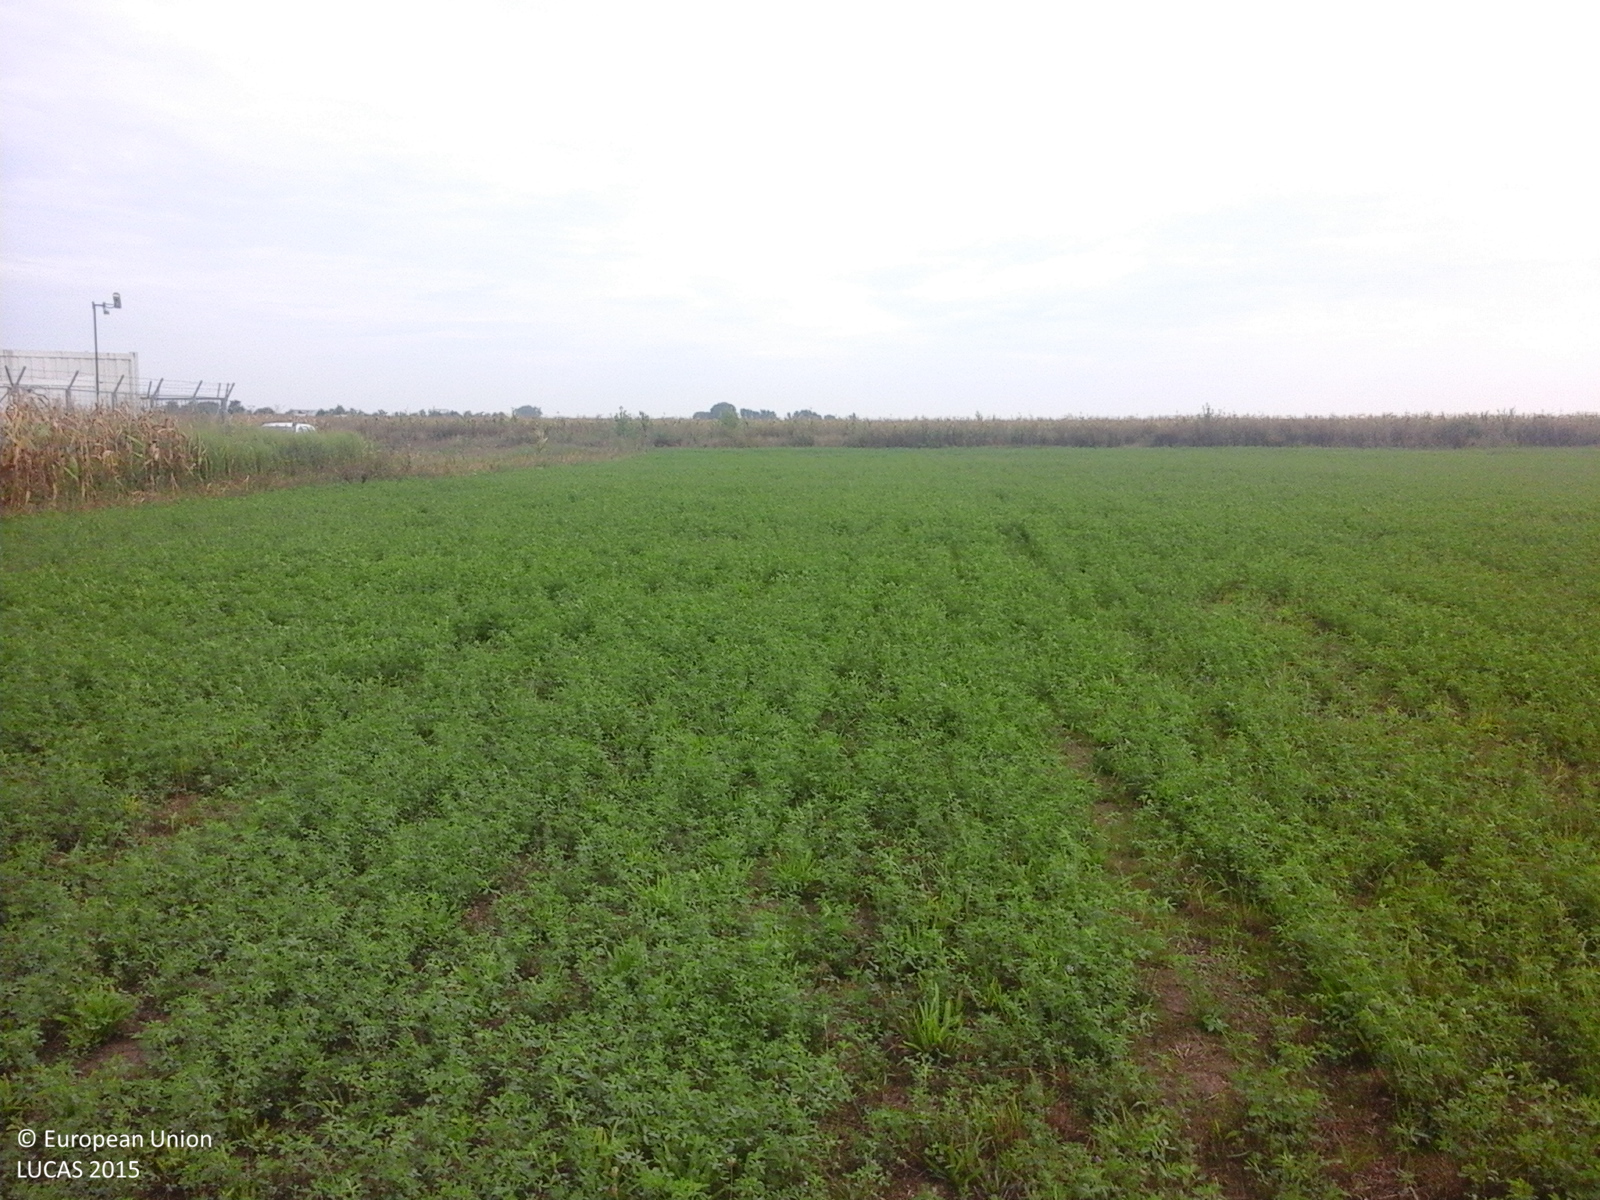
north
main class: Cropland
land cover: Lucerne
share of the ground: > 75 %
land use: Agriculture (excluding fallow land and kitchen gardens)
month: August
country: RO
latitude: 46.1057
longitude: 20.8567
